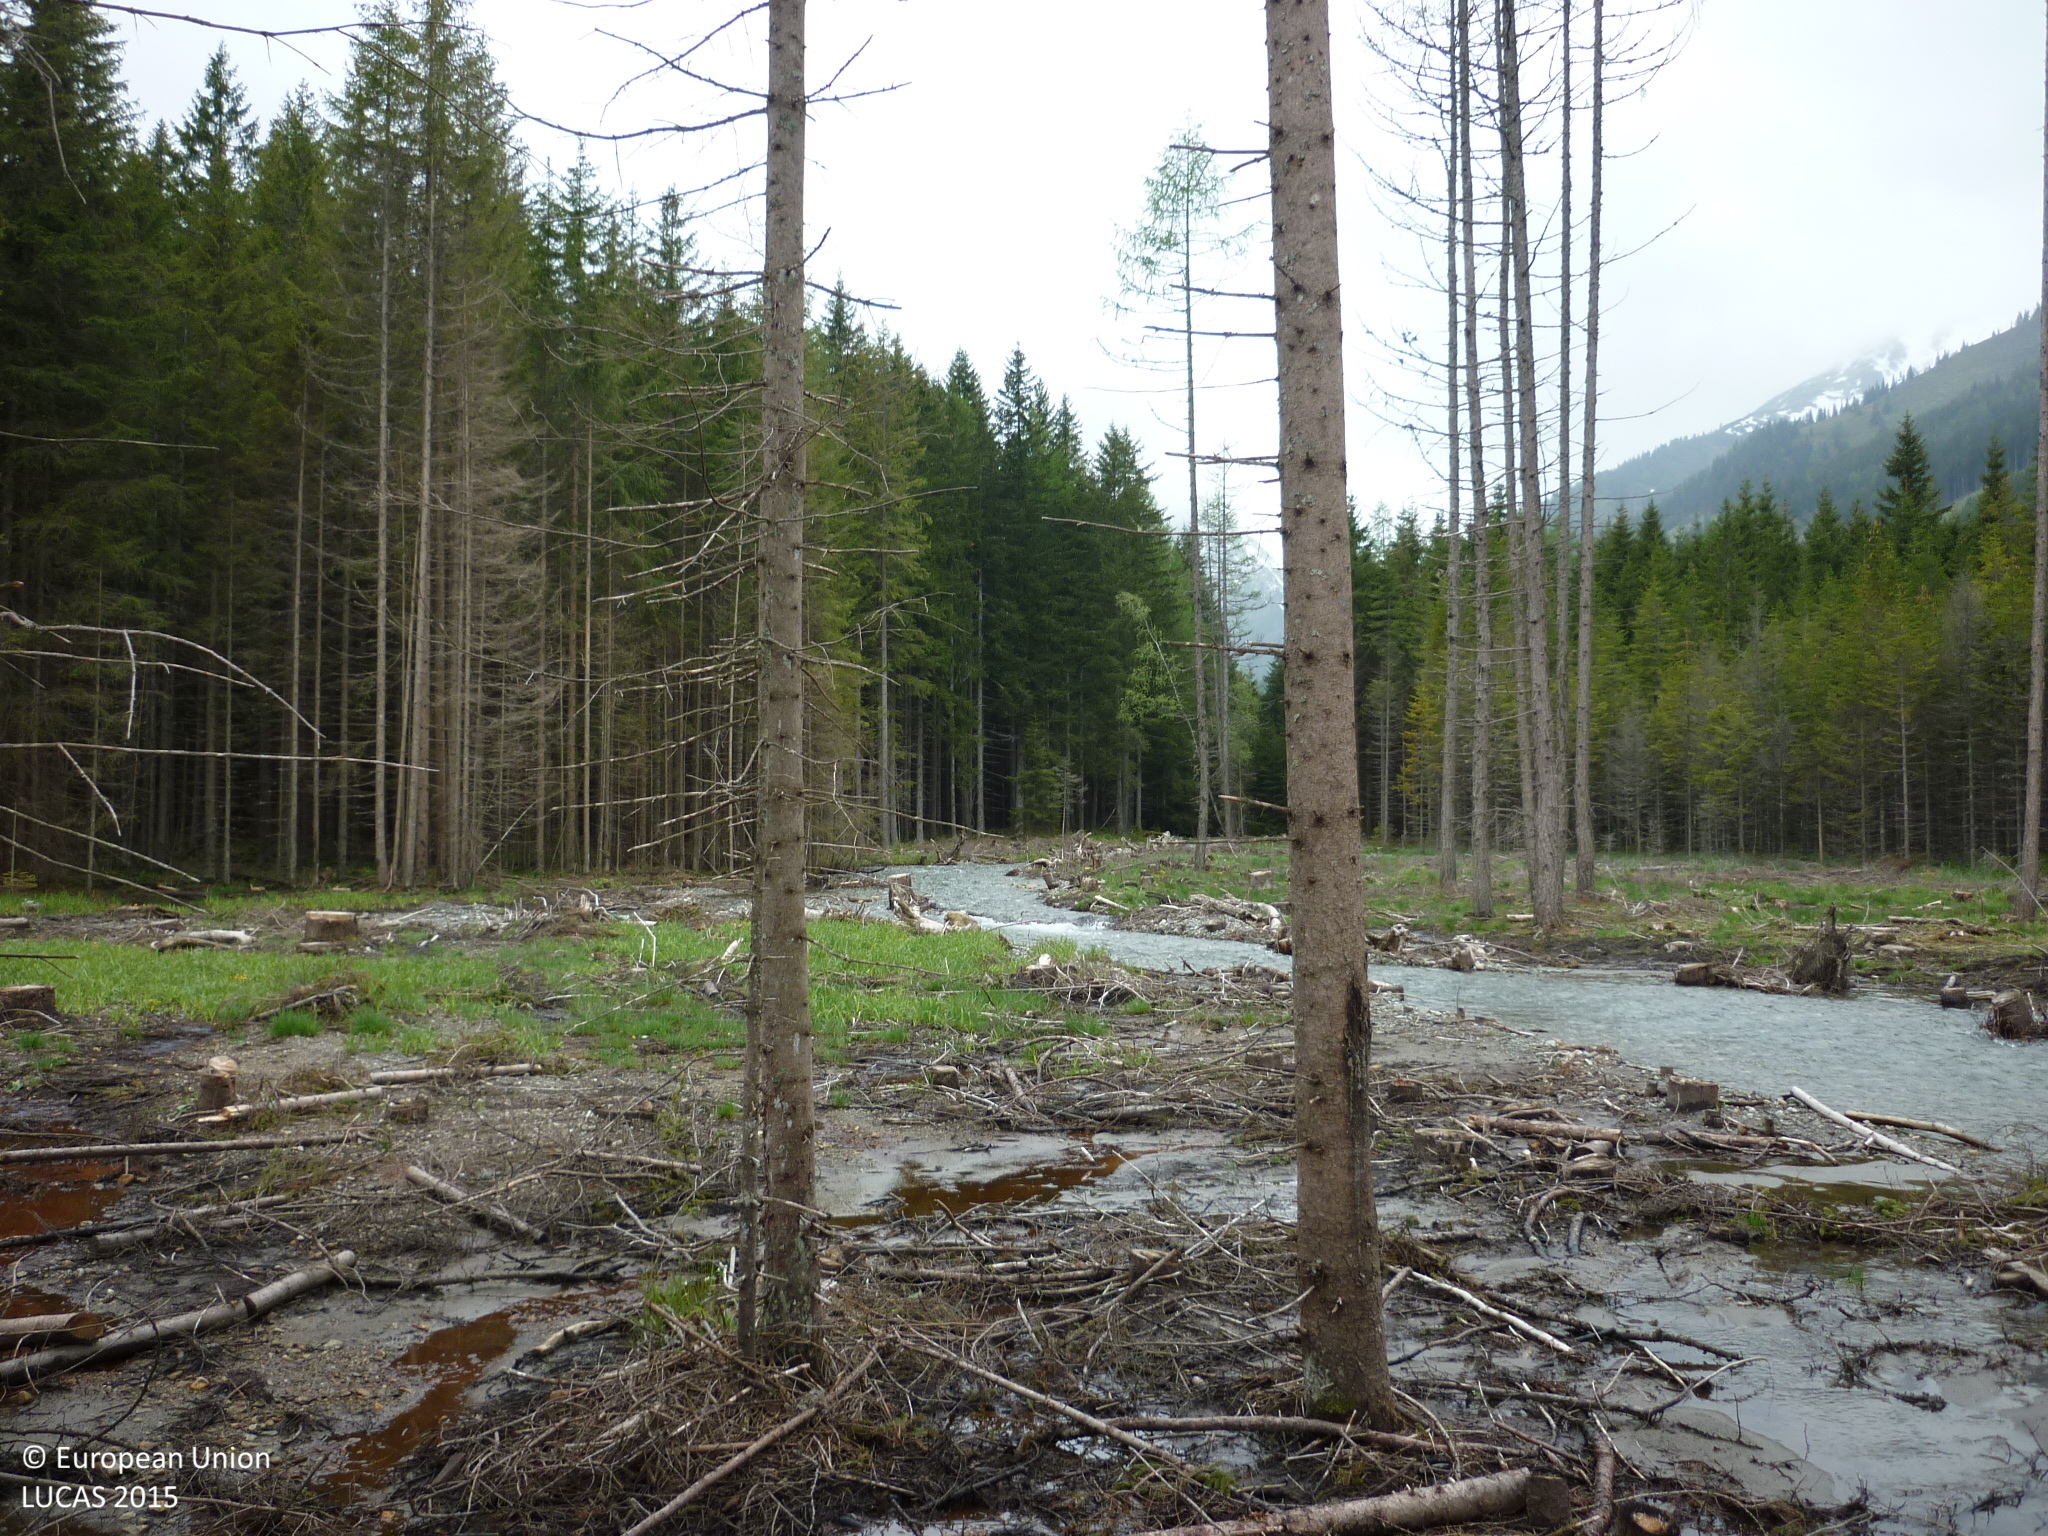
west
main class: Woodland
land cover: Spruce dominated coniferous woodland
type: alpine coniferous forest
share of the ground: 50 - 75 %
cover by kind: coniferous forest trees 60 %, consolidated bare surface 10 %, unconsolidated bare surface 10 %
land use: Forestry
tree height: > 5 m
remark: Temporary flooded
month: May
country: AT
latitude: 47.4132
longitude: 14.4389
